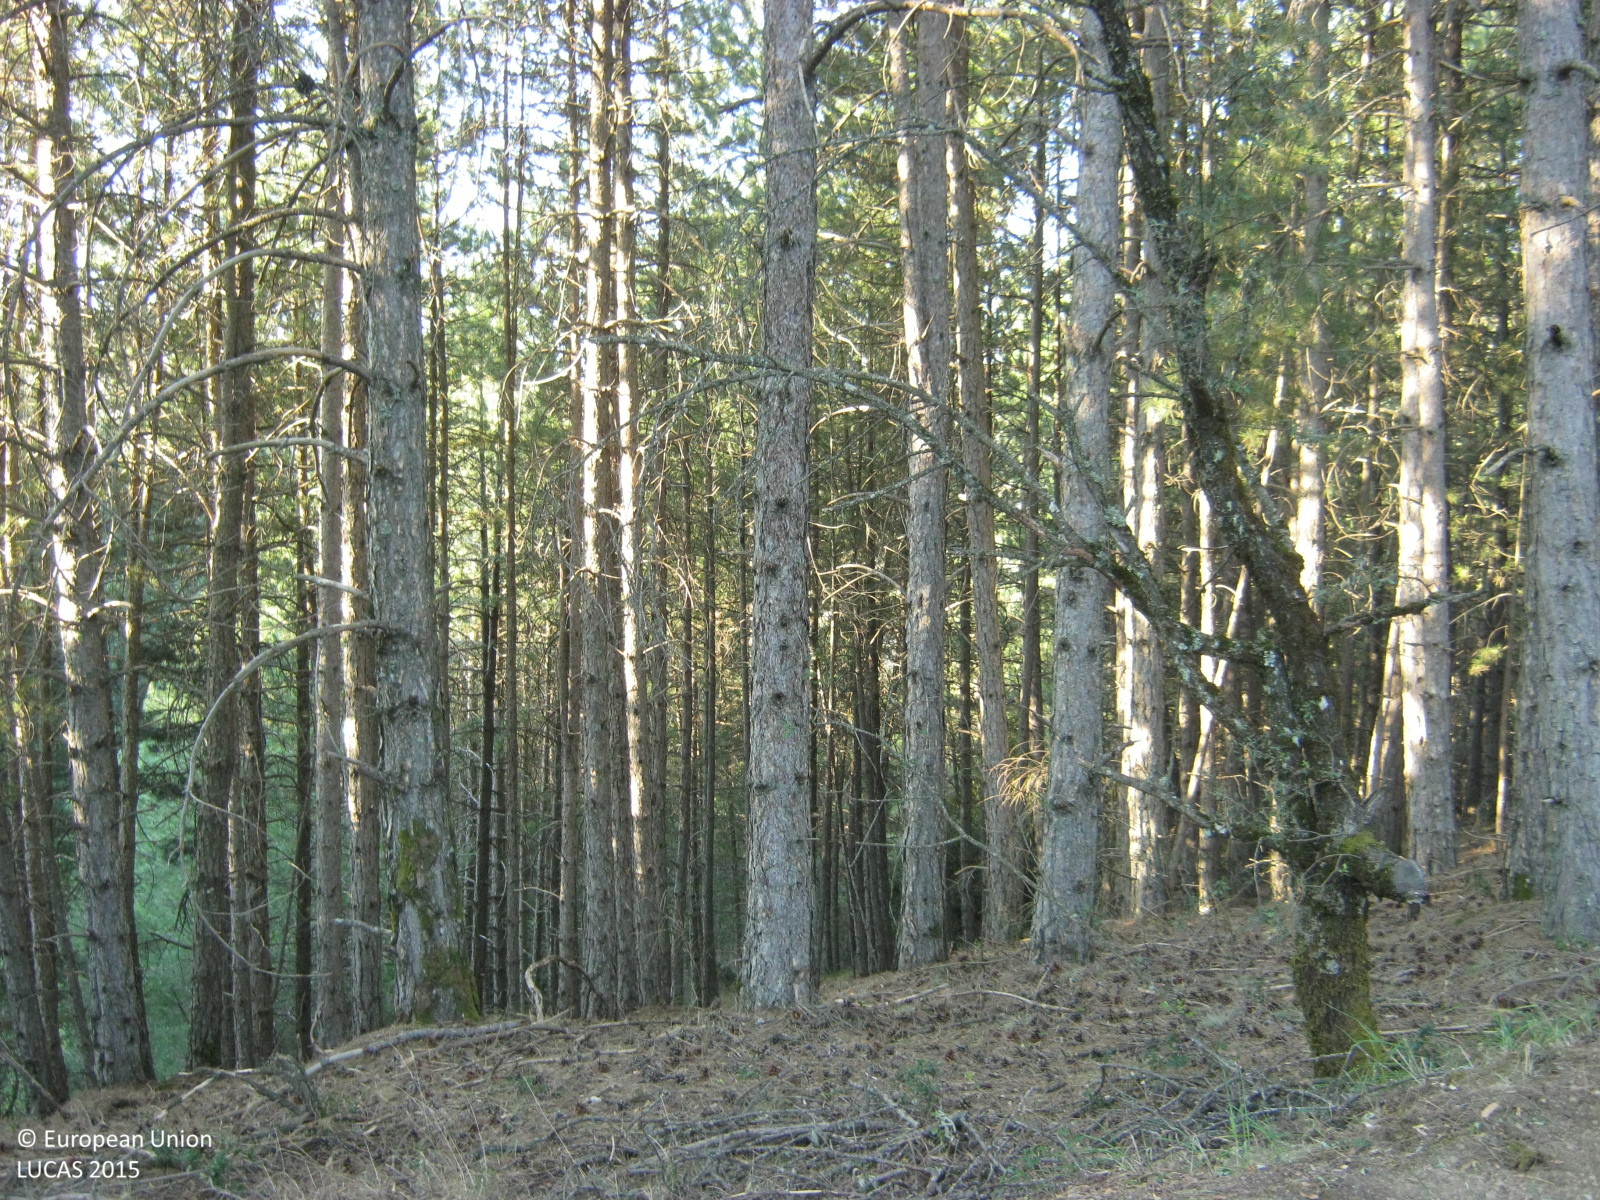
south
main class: Woodland
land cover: Other mixed woodland
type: coniferous forest of the mediterranean region
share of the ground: 50 - 75 %
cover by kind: coniferous forest trees 30 %, broadleaved forest trees 30 %, shrubs 30 %, herbaceous plants 10 %
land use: Semi-natural and natural areas not in use
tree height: > 5 m
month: August
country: GR
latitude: 37.6759
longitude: 22.0371
